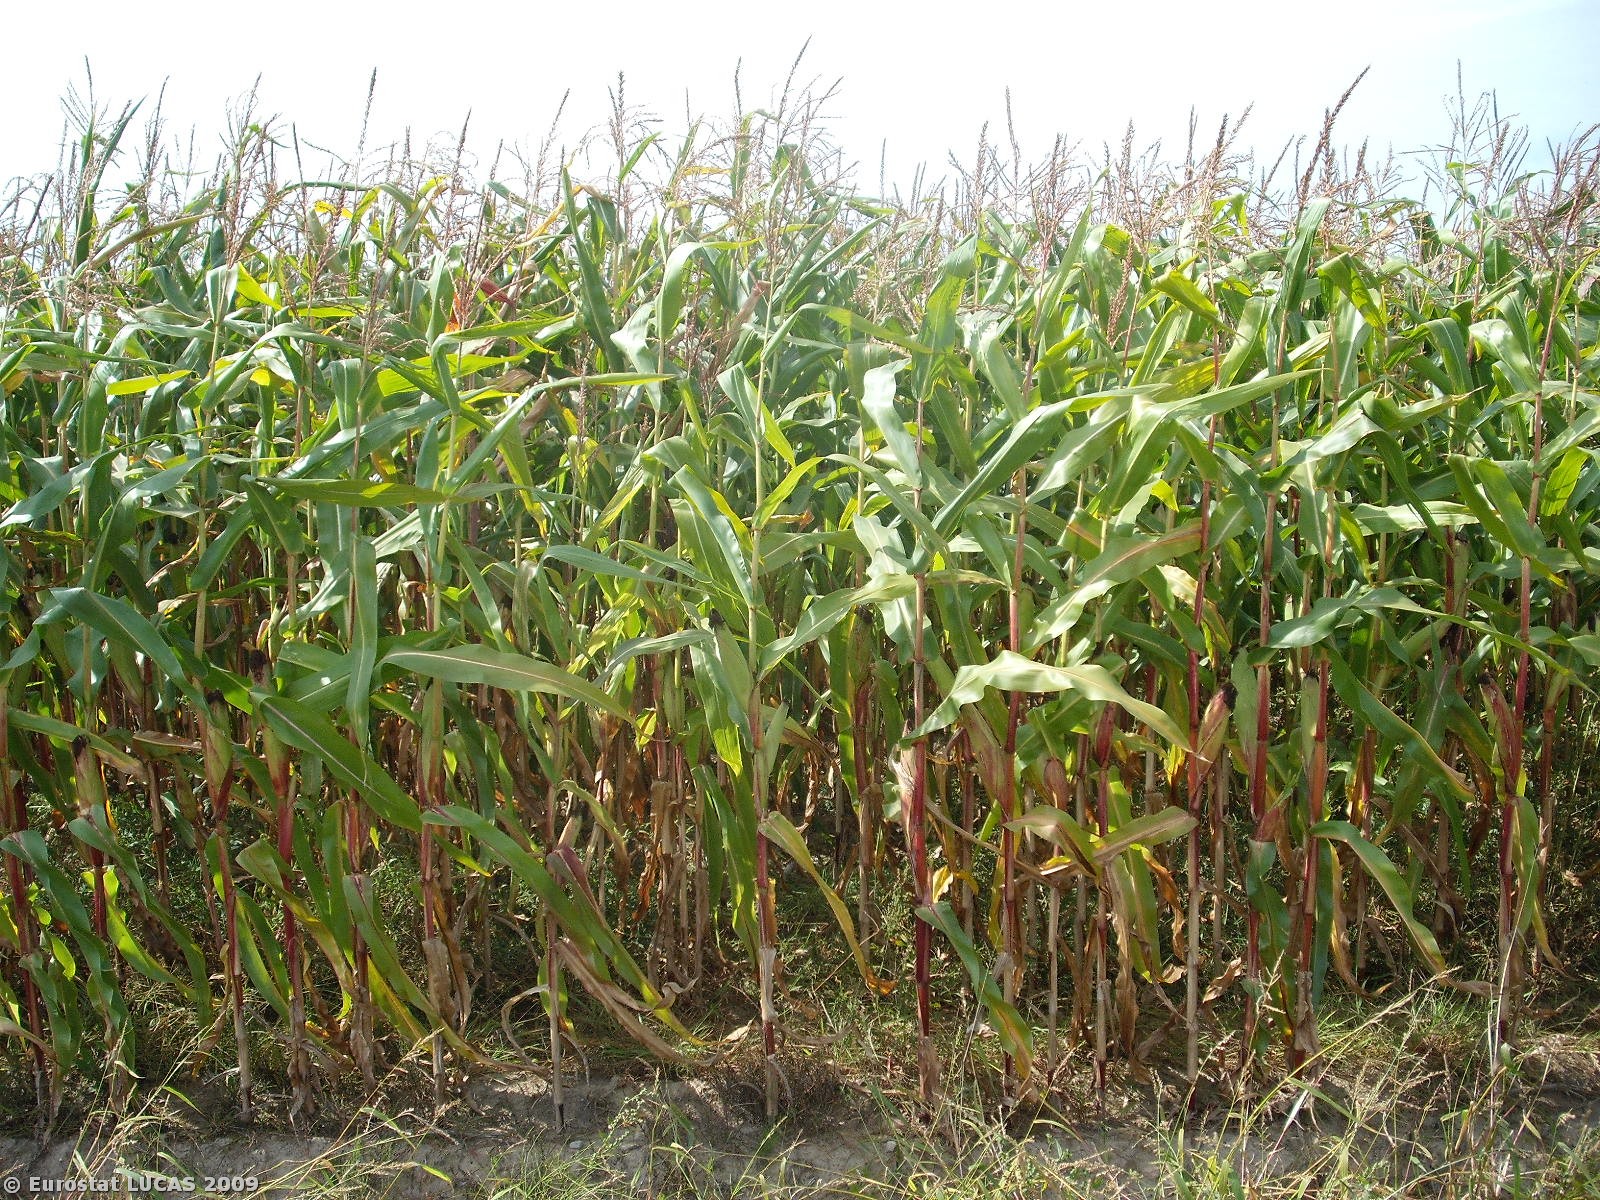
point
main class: Cropland
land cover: Maize
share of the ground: > 75 %
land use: Agriculture (excluding fallow land and kitchen gardens)
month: September
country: PL
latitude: 51.8767
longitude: 22.1610
